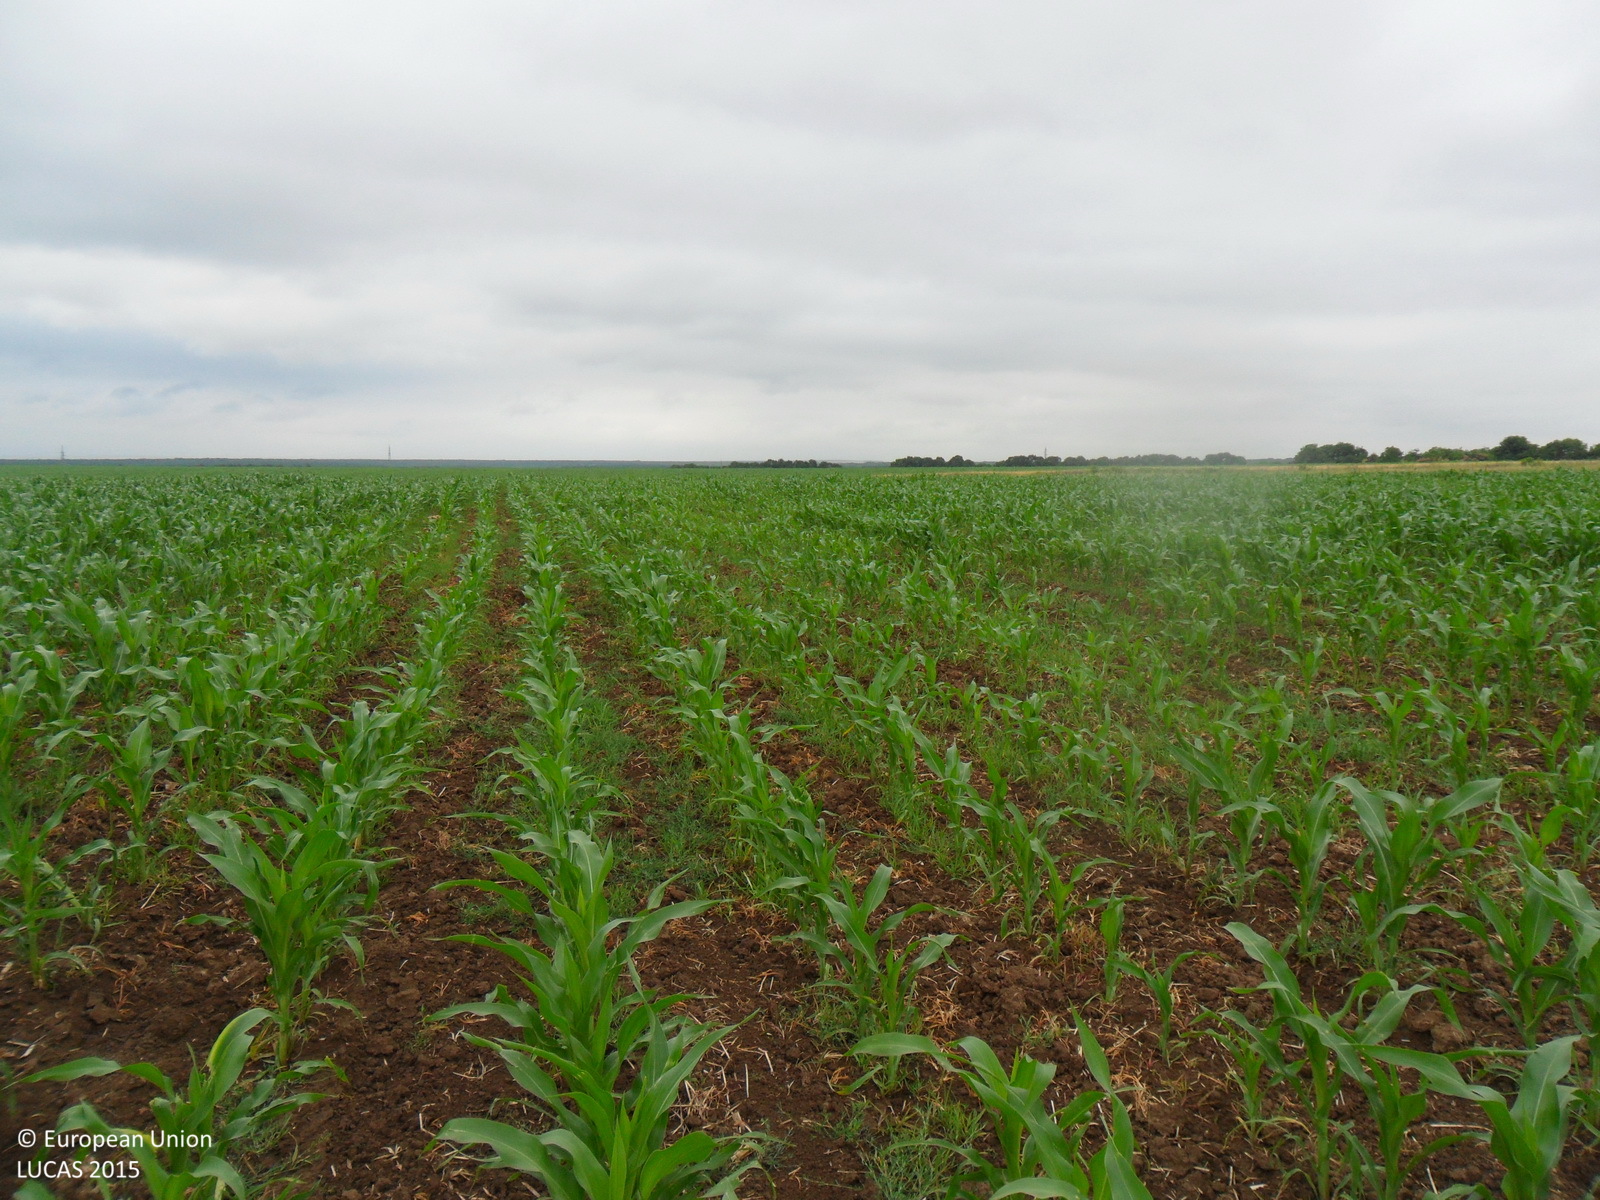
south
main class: Cropland
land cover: Maize
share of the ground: 25 - 50 %
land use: Agriculture (excluding fallow land and kitchen gardens)
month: June
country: BG
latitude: 43.7453
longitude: 26.6646
